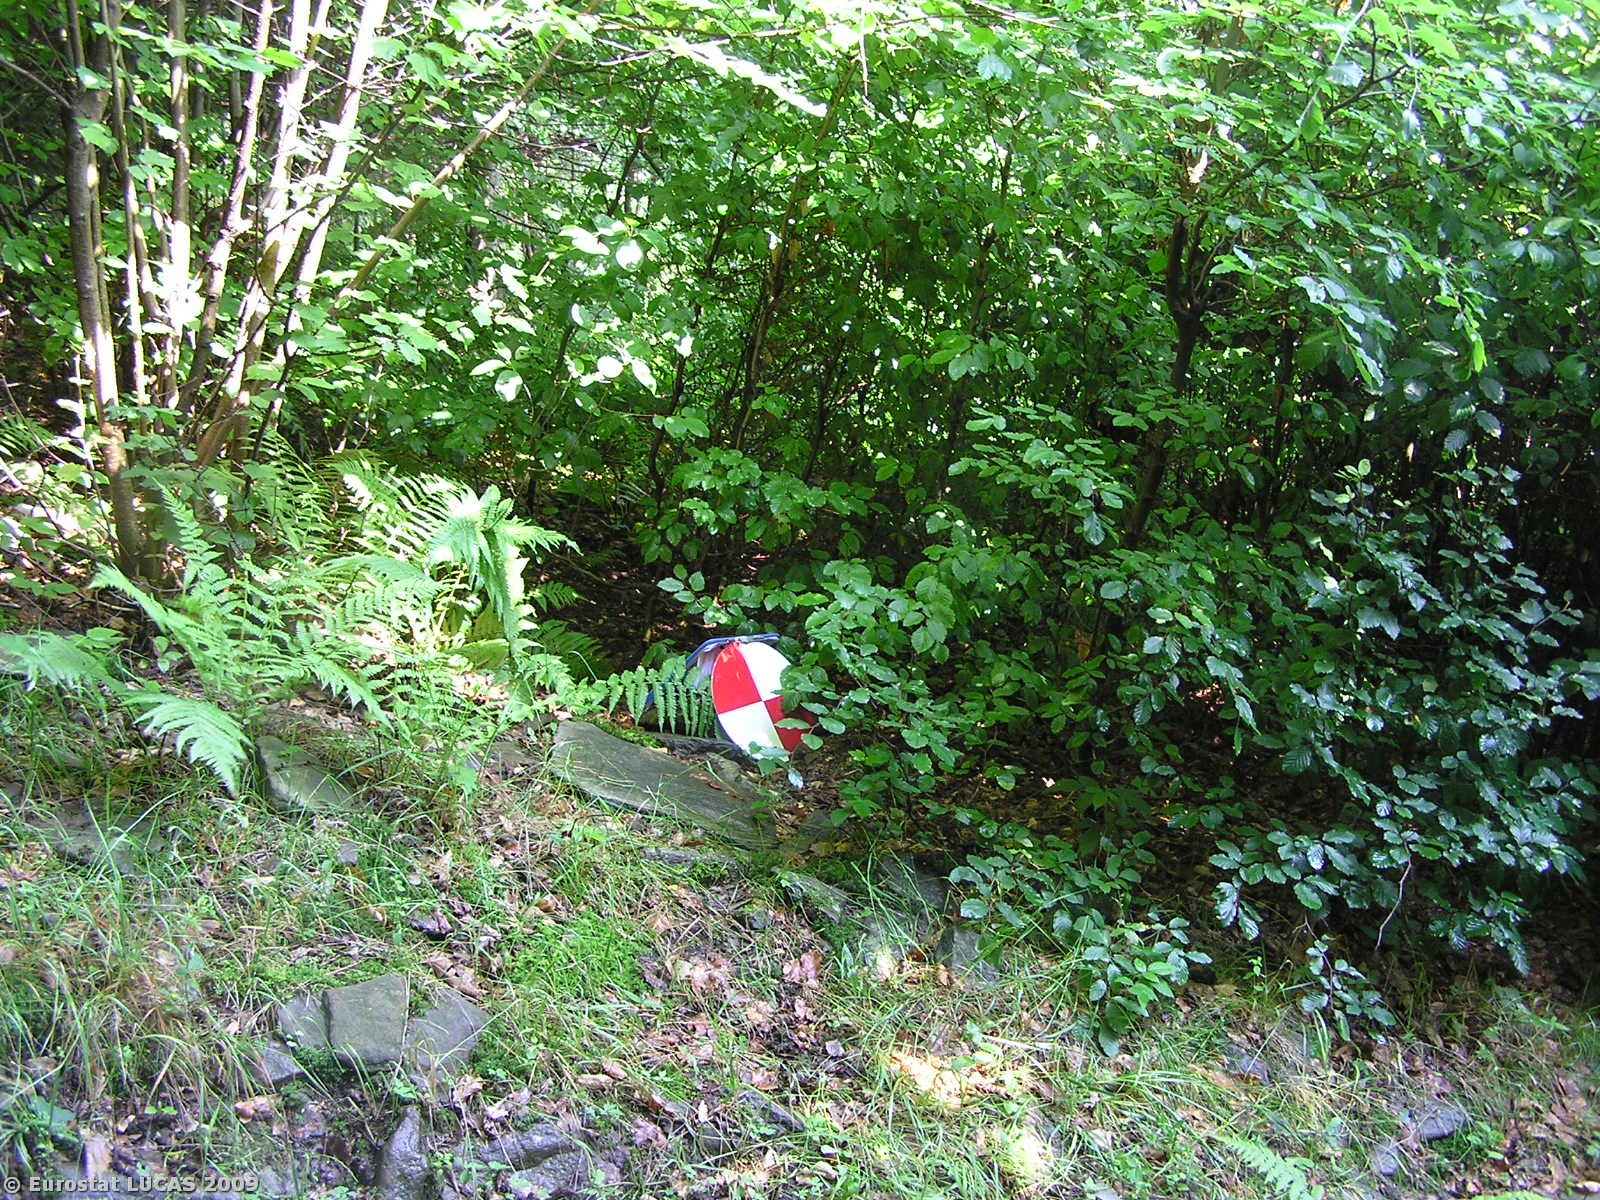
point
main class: Woodland
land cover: Mixed woodland
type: hemiboreal forest and nemoral coniferous forest and mixed broadleaved-coniferous forest
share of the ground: > 75 %
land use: Forestry
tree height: > 5 m
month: June
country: CZ
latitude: 50.2647
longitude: 17.4615
